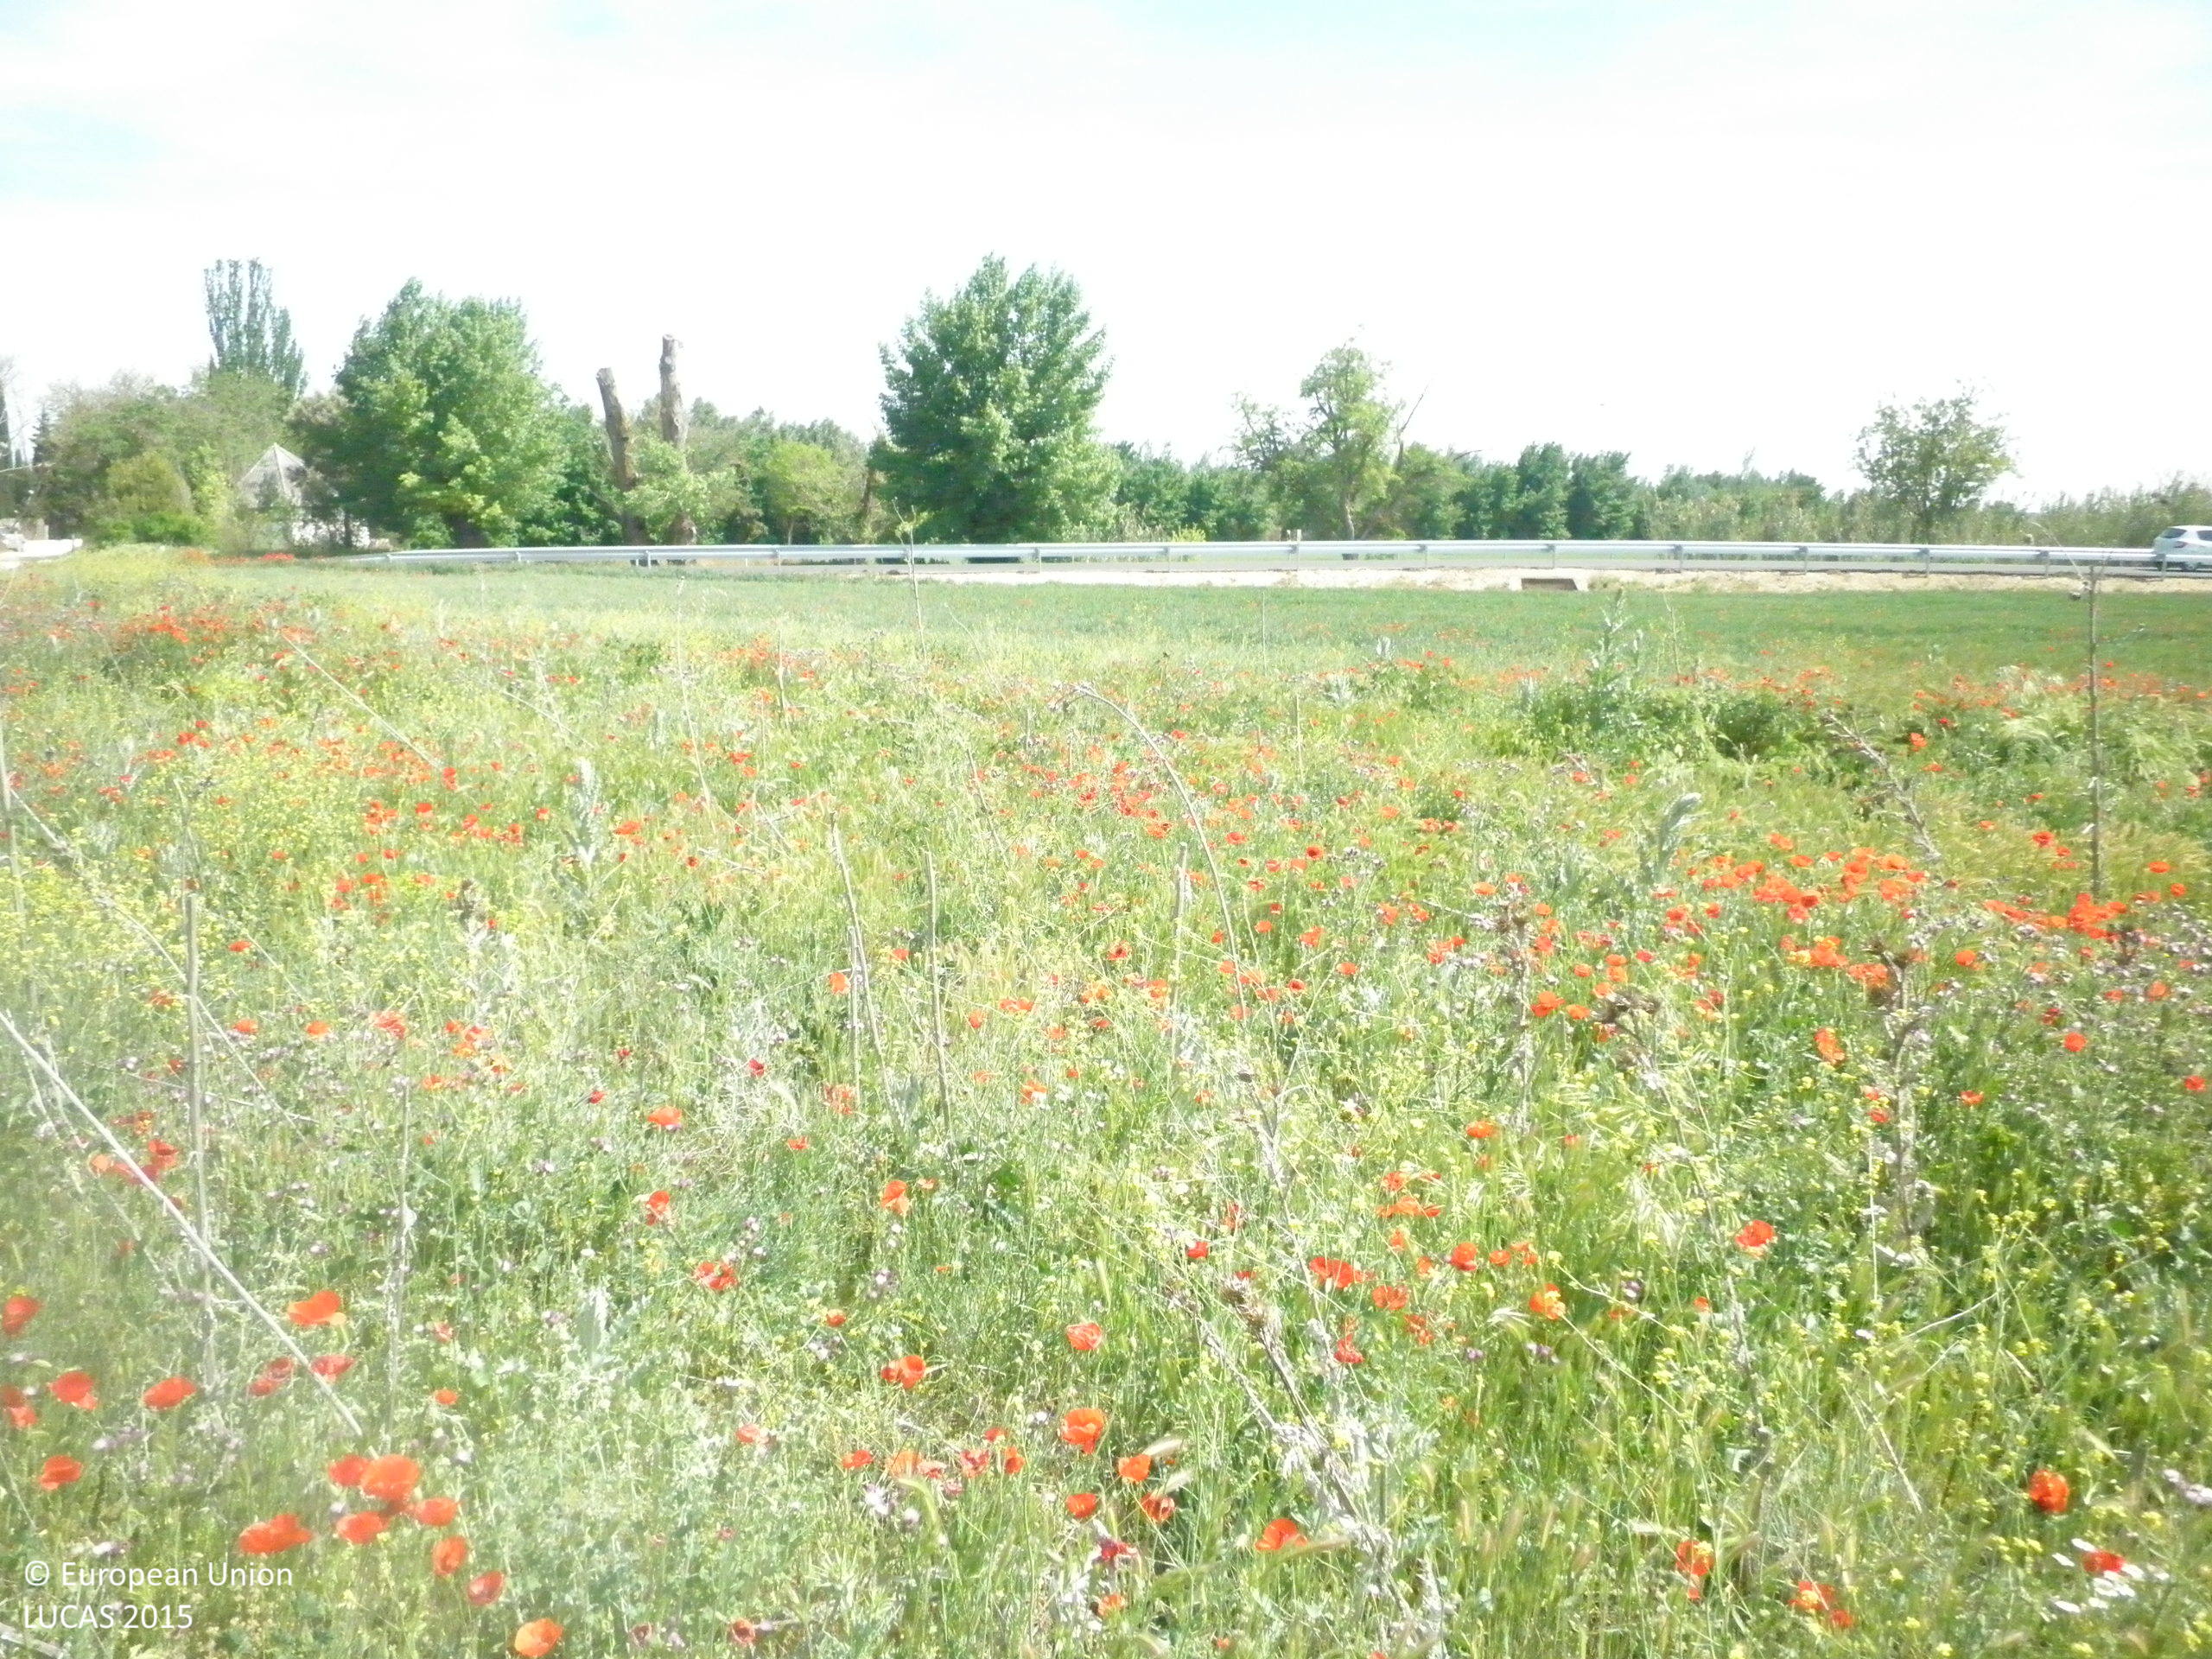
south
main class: Grassland
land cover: Grassland without tree/shrub cover
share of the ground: > 75 %
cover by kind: herbaceous plants 90 %, consolidated bare surface 10 %
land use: Abandoned areas
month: May
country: ES
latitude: 39.5346
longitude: -2.8020
